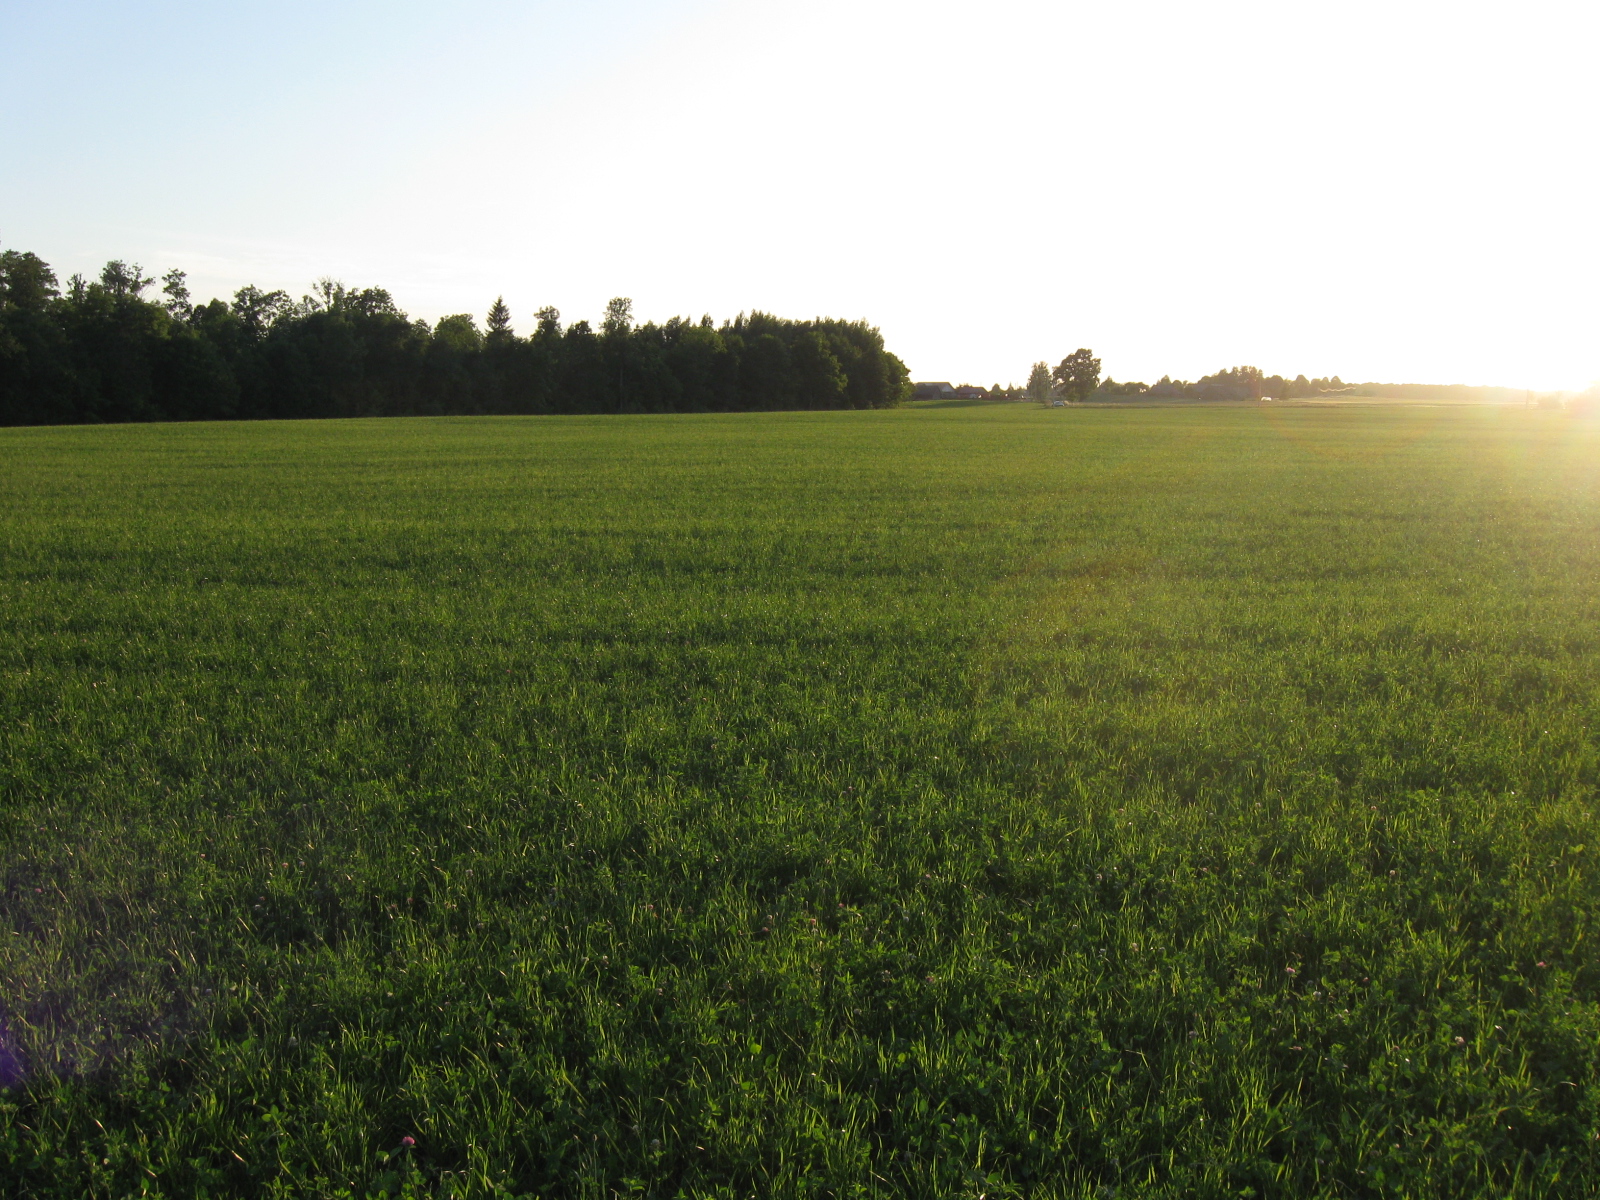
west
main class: Cropland
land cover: Other leguminous and mixtures for fodder
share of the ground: > 75 %
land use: Agriculture (excluding fallow land and kitchen gardens)
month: July
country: LT
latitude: 55.0900
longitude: 23.6360
